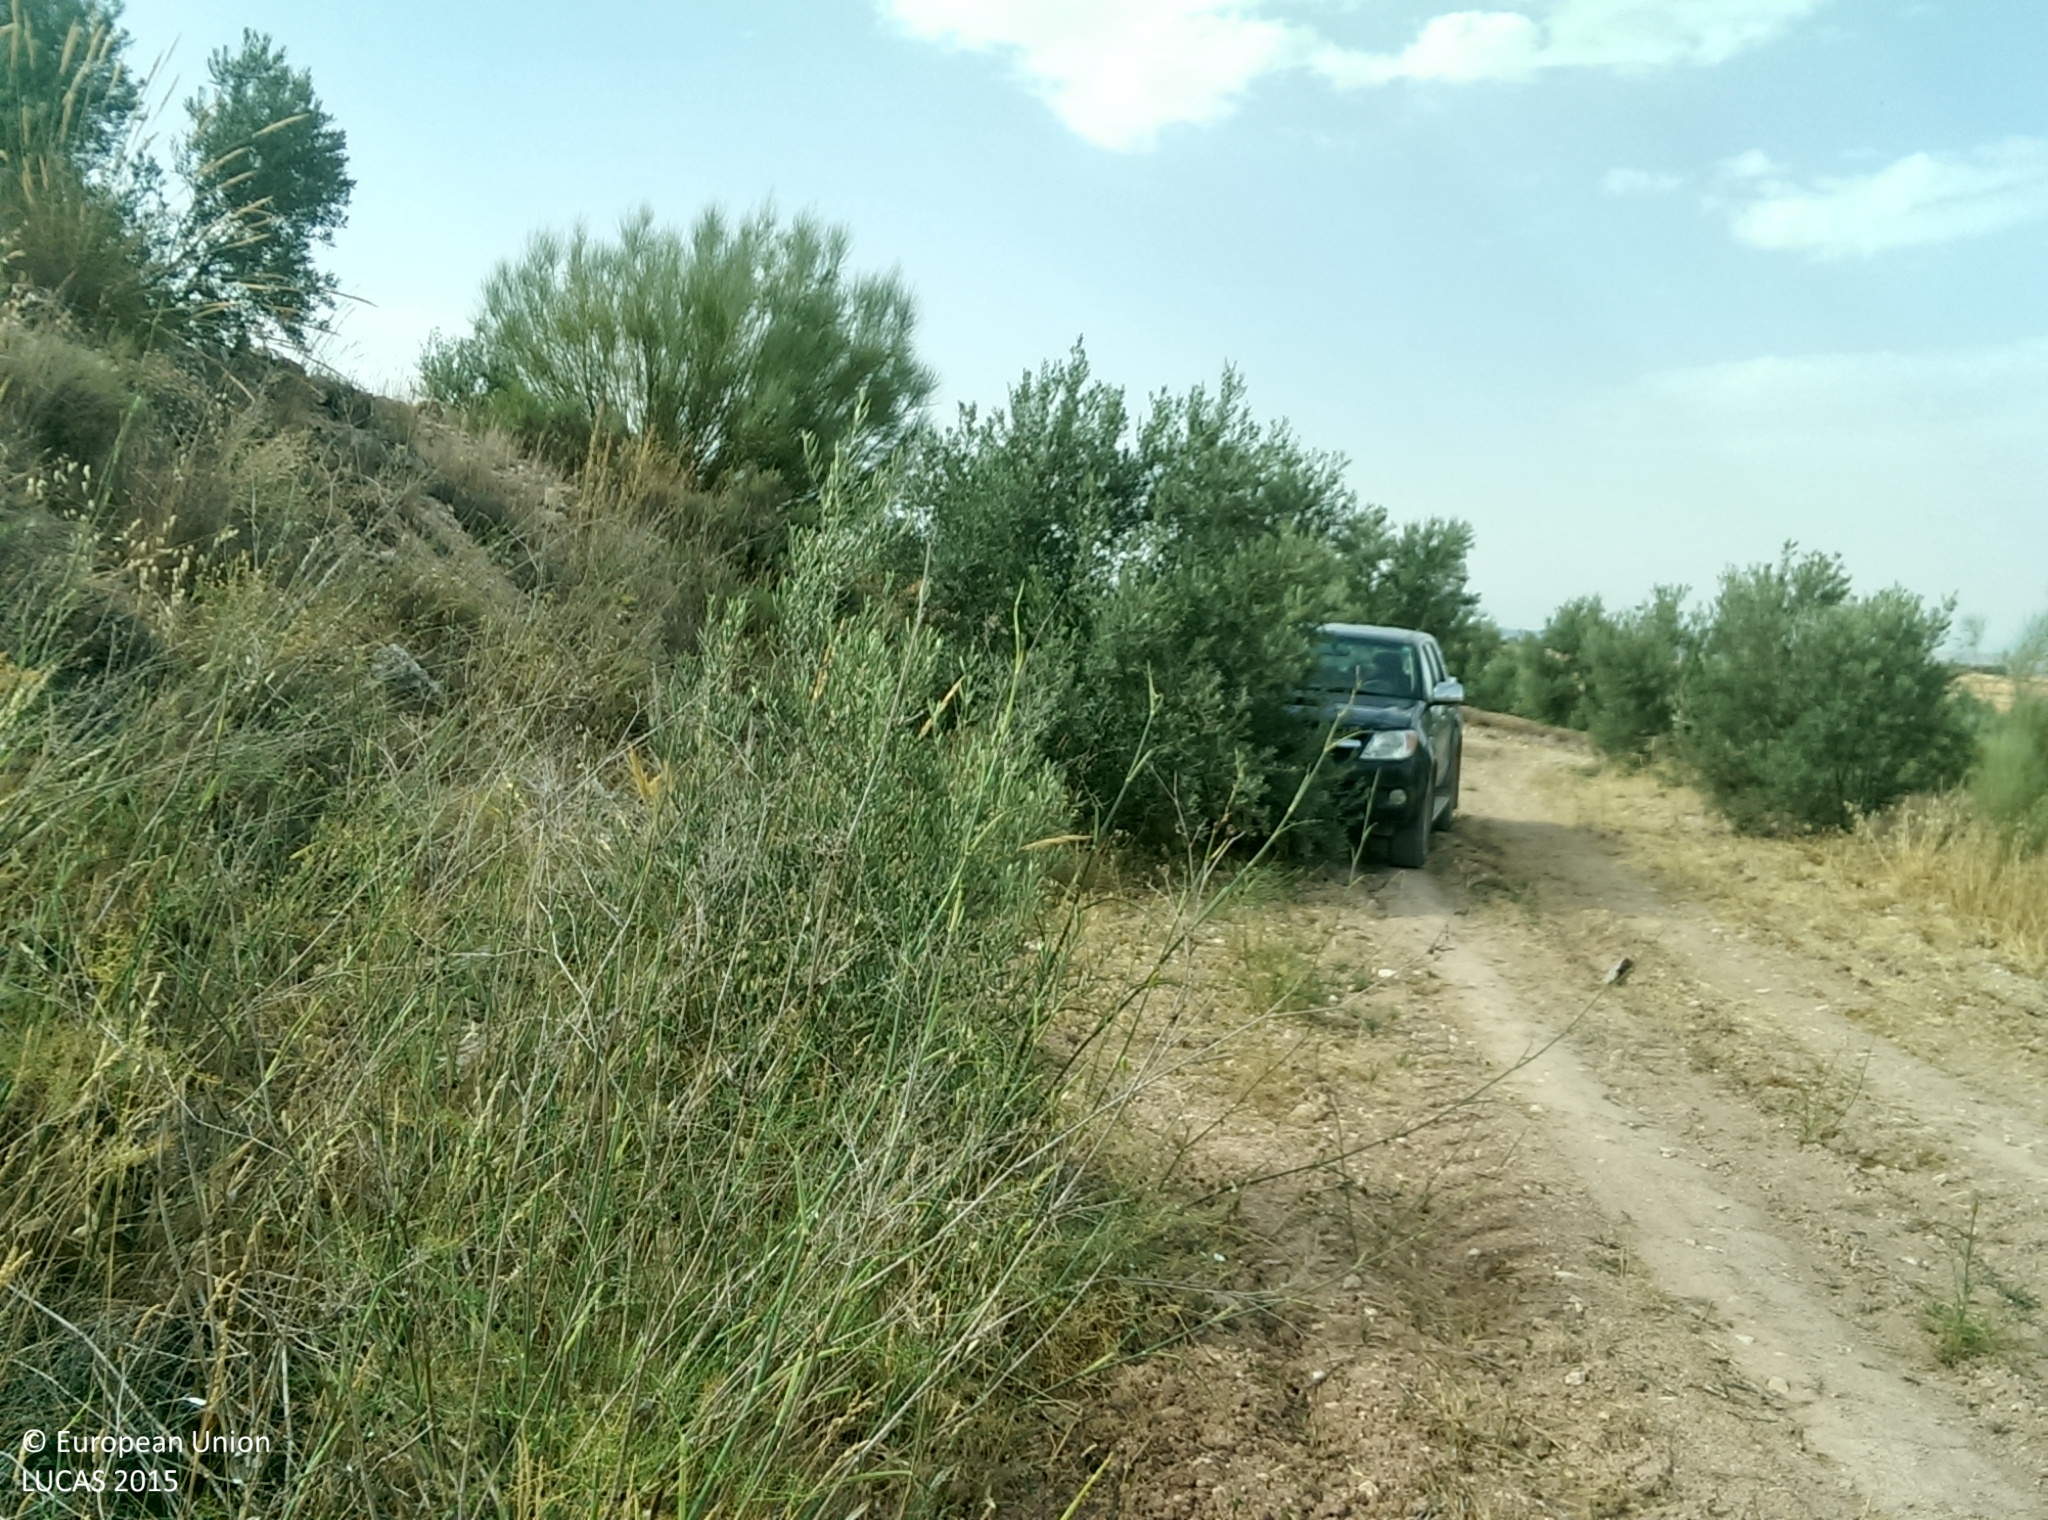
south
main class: Cropland
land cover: Olive groves
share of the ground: 10 - 25 %
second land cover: Spontaneously vegetated surfaces
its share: 50 - 75 %
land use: Agriculture (excluding fallow land and kitchen gardens)
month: July
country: ES
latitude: 37.5937
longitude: -2.9351
